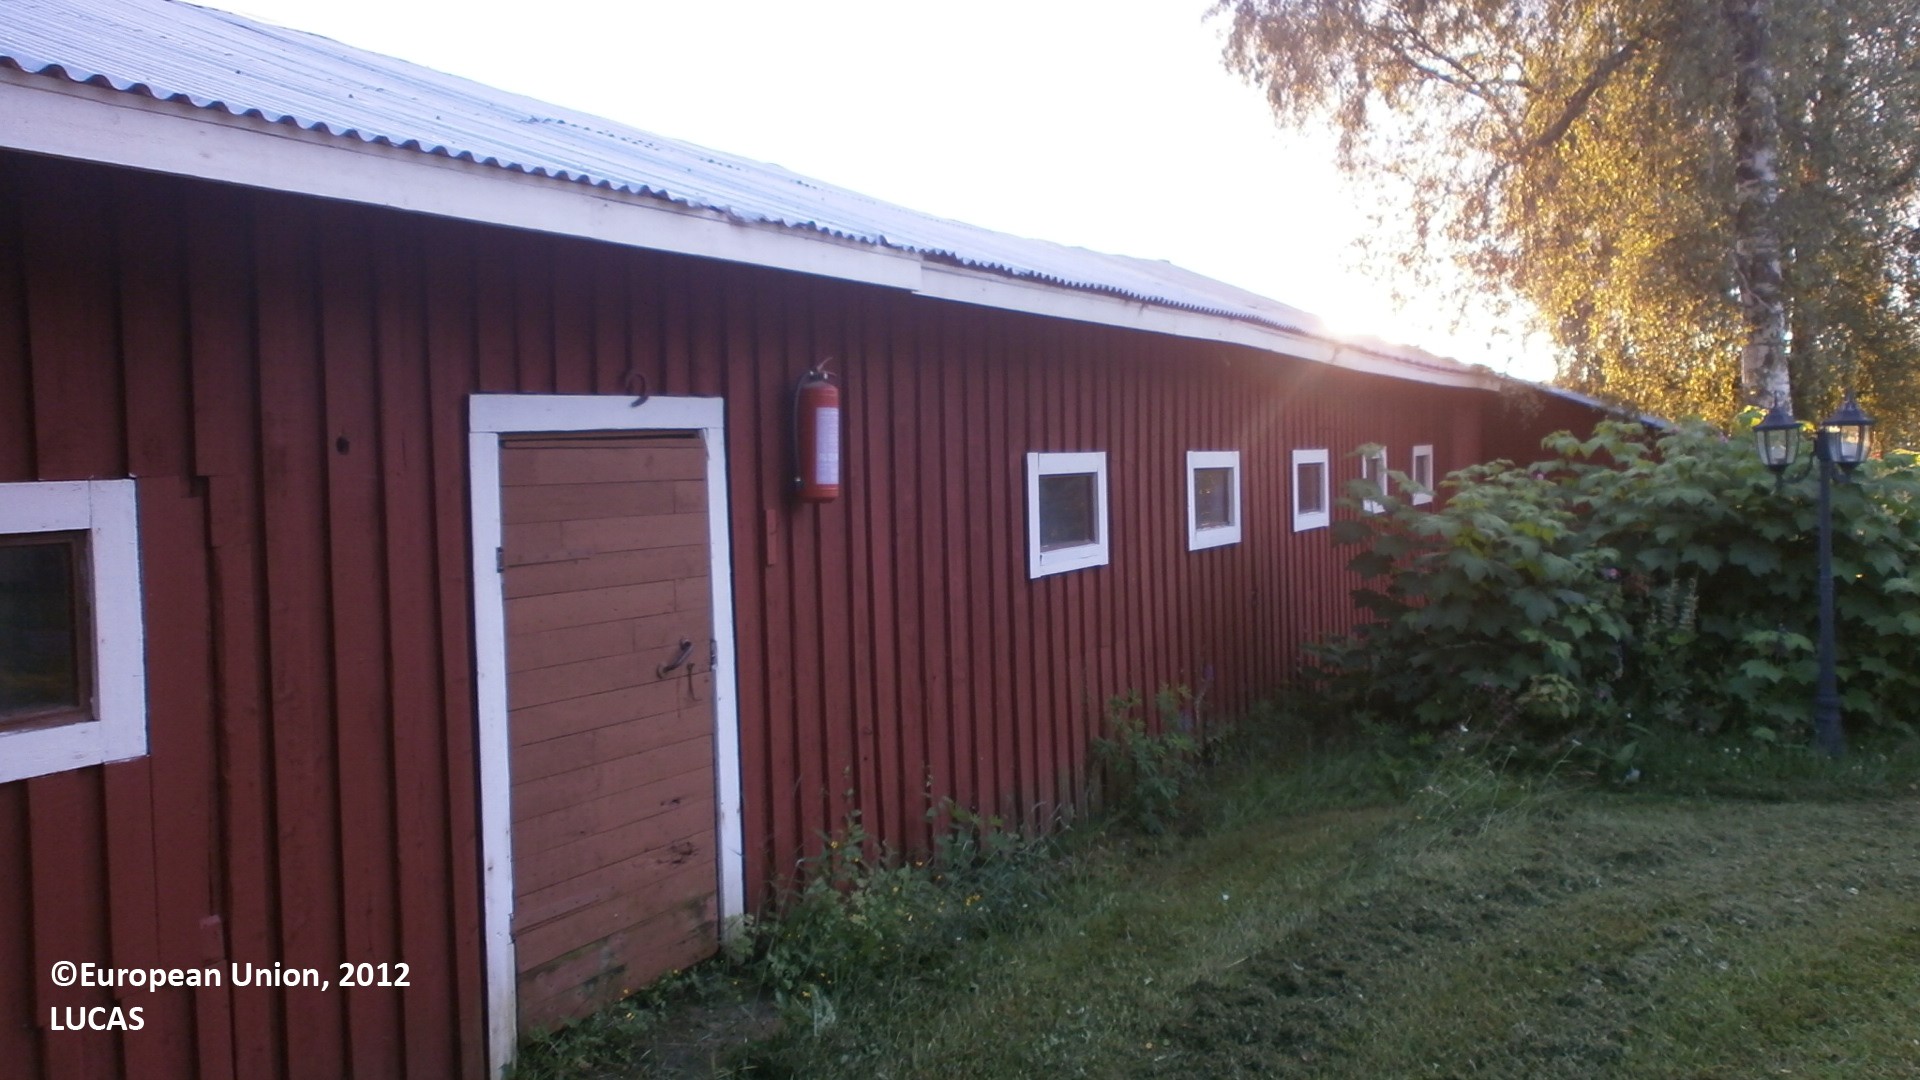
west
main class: Grassland
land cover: Grassland without tree/shrub cover
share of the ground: > 75 %
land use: Residential
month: July
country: FI
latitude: 64.1225
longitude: 24.0080
